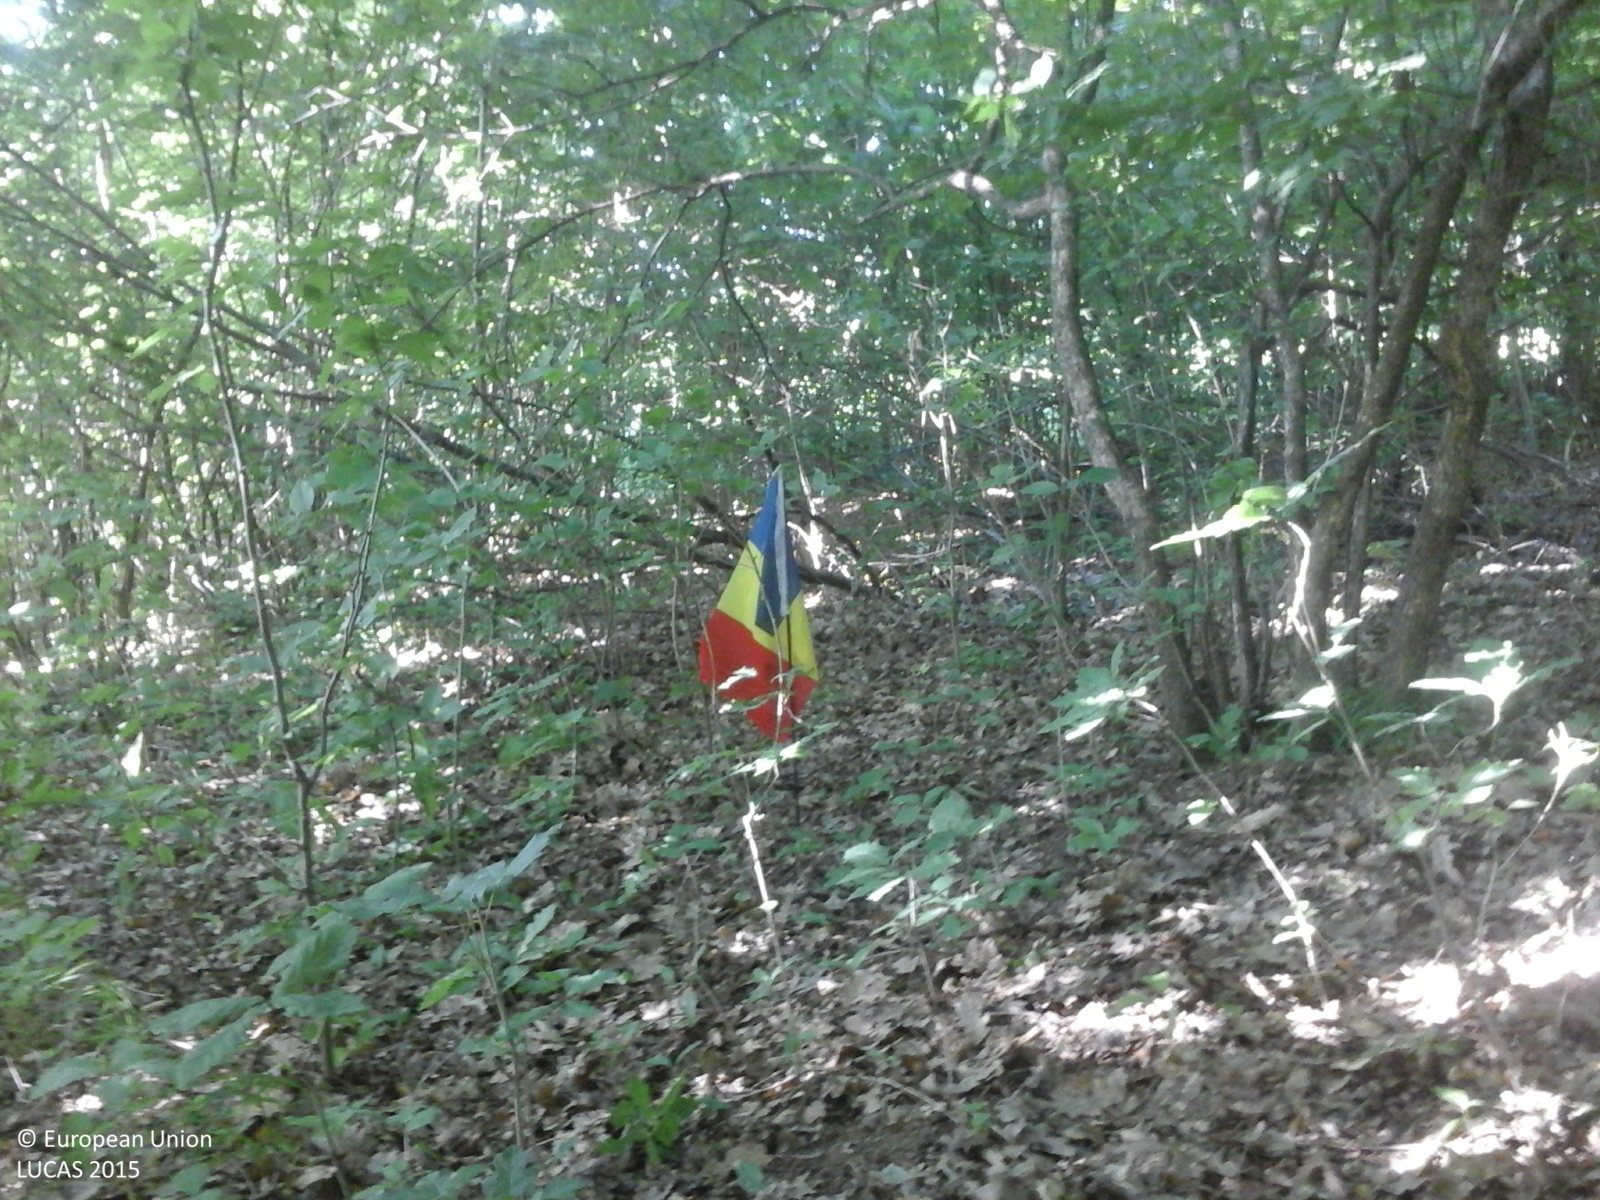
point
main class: Woodland
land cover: Broadleaved woodland
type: acidophilous oak and oak-birch forest
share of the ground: > 75 %
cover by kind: broadleaved forest trees 100 %
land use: Forestry
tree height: > 5 m
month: June
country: RO
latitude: 45.1208
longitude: 26.2217
